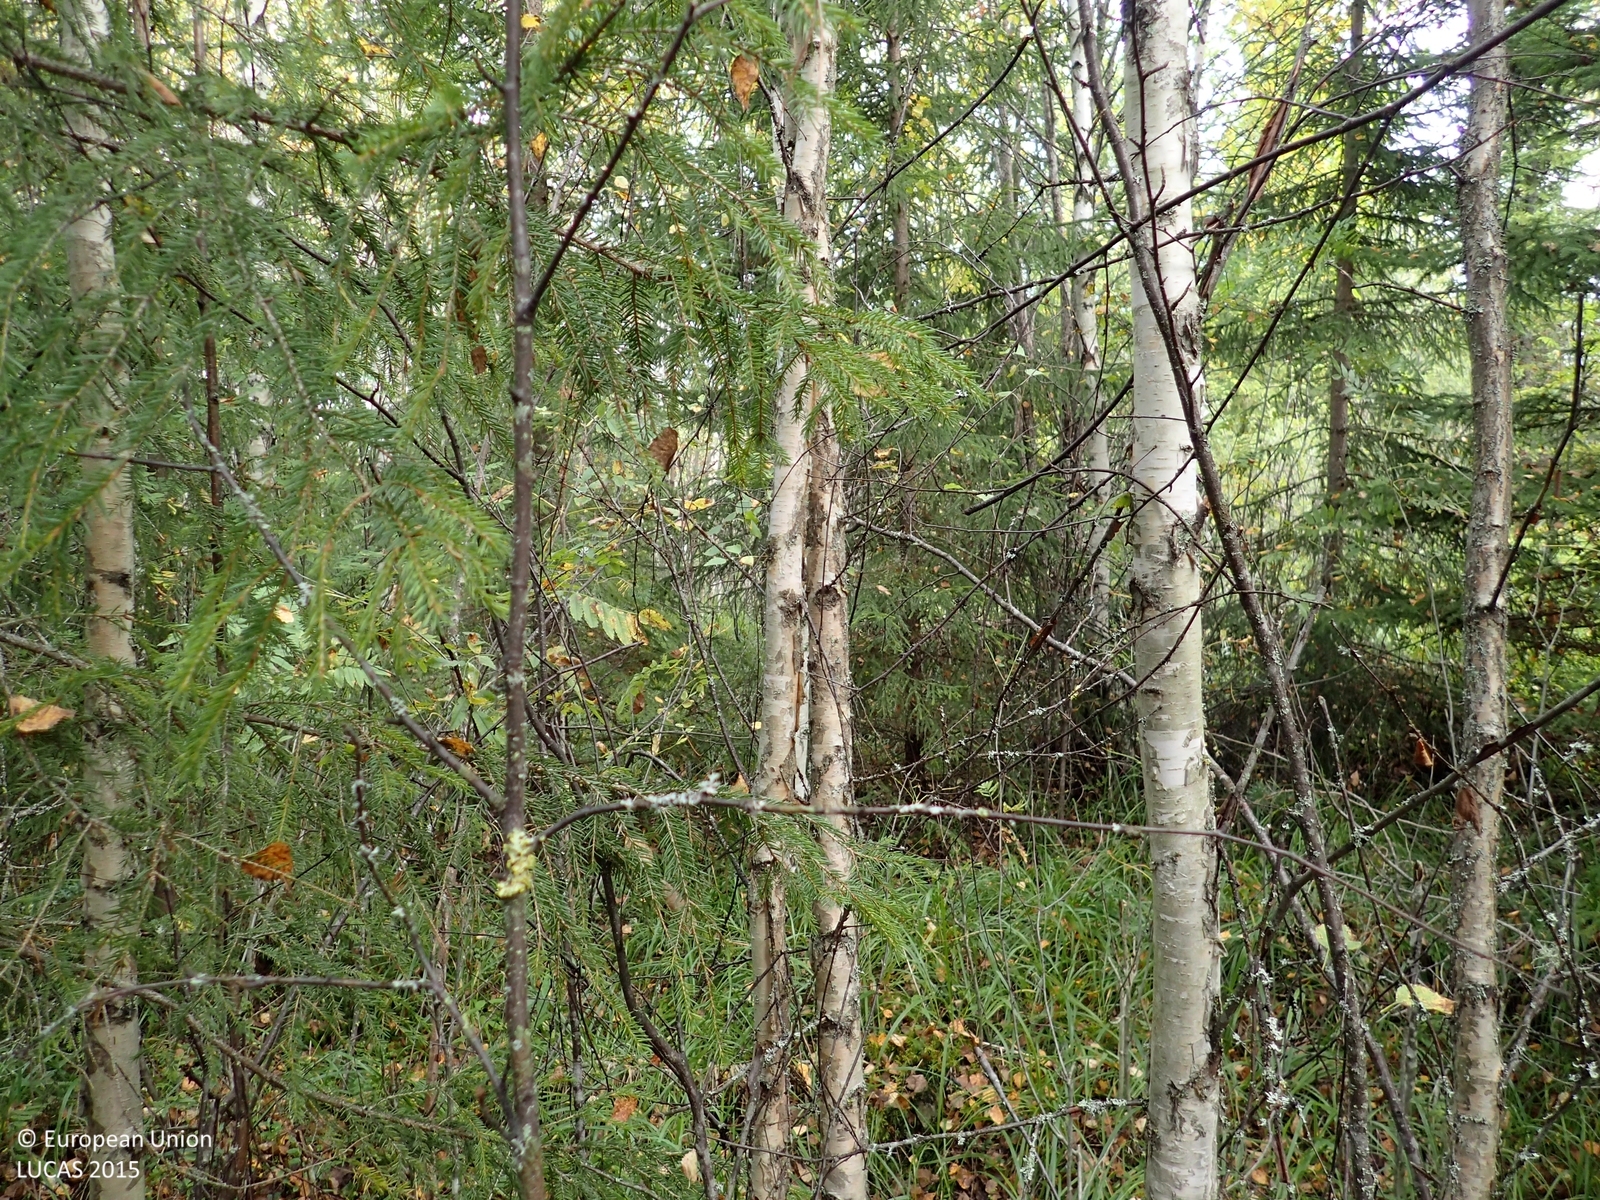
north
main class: Woodland
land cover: Spruce dominated mixed woodland
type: boreal forest
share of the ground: > 75 %
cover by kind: broadleaved forest trees 55 %, coniferous forest trees 30 %, herbaceous plants 10 %, lichens and mosses 5 %
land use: Forestry
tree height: > 5 m
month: September
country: FI
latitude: 63.0772
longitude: 26.0147
